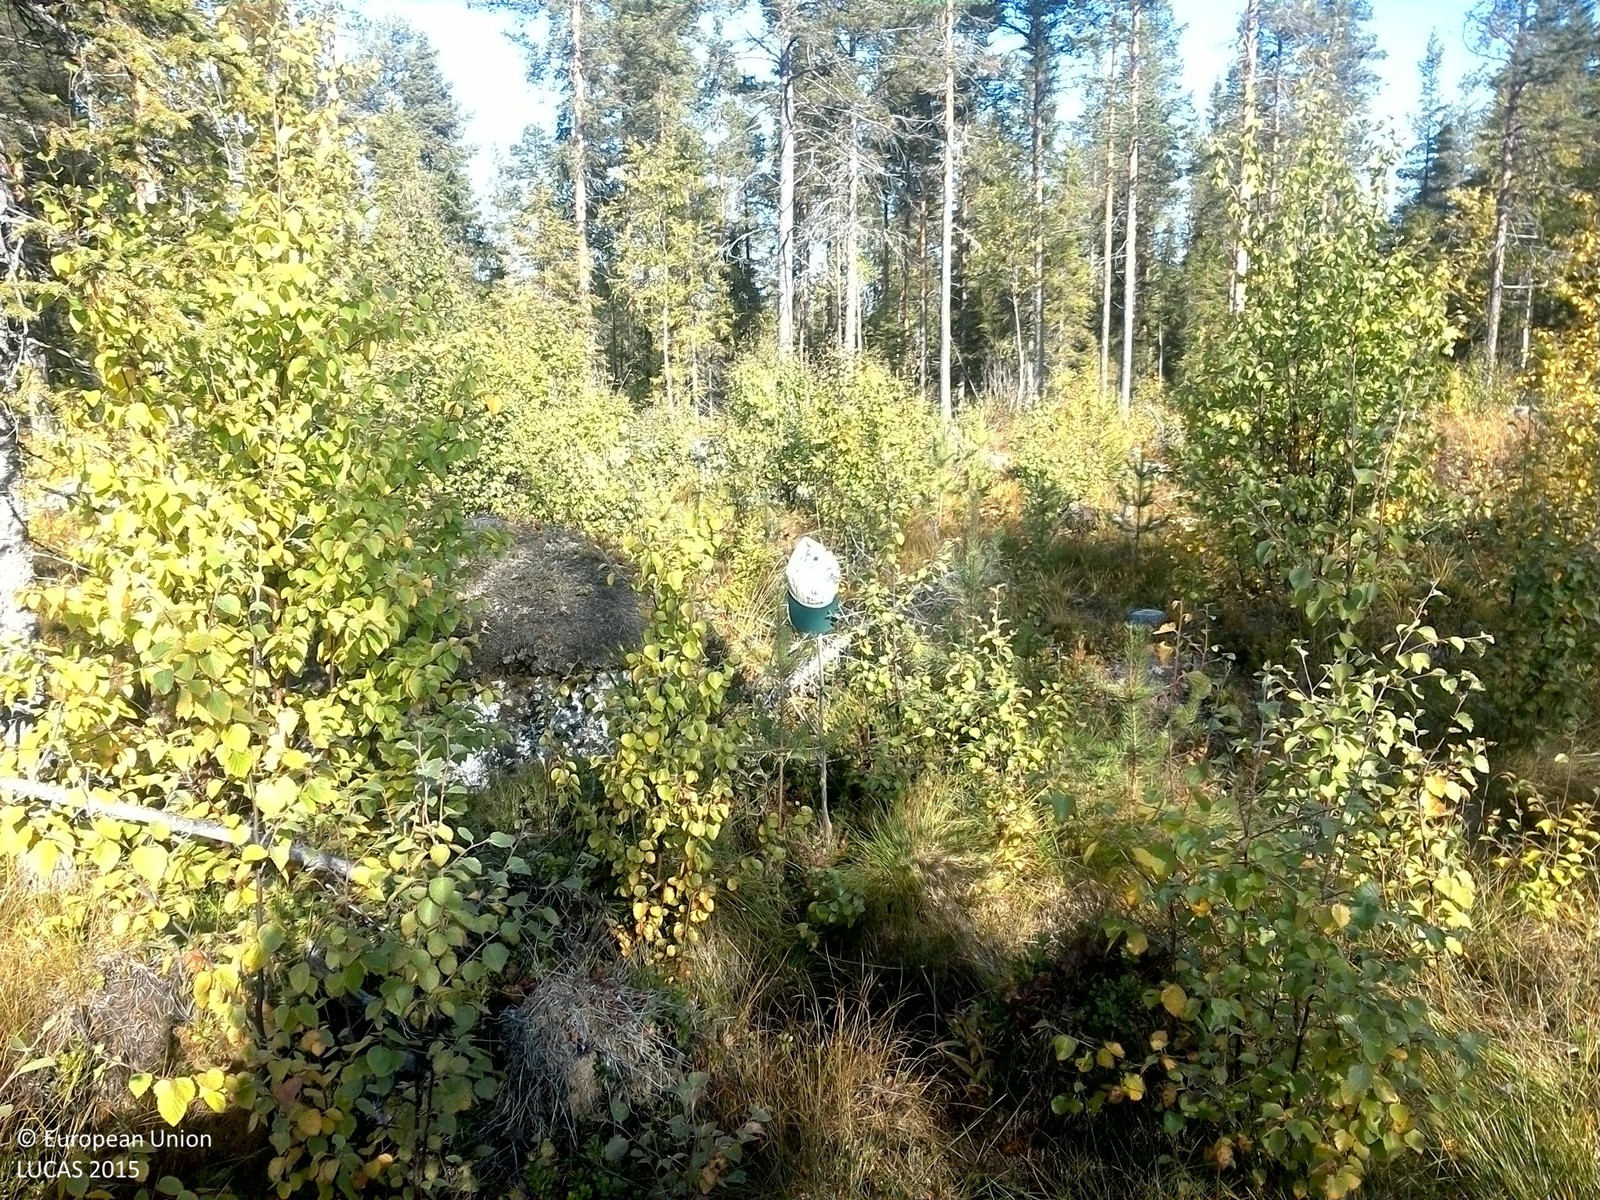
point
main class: Woodland
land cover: Broadleaved woodland
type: boreal forest
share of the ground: 25 - 50 %
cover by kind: broadleaved forest trees 35 %, herbaceous plants 35 %, coniferous forest trees 10 %, shrubs 10 %, lichens and mosses 5 %, unconsolidated bare surface 5 %
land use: Forestry
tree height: < 5 m
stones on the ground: < 10 %
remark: Clear cut
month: September
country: SE
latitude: 64.0636
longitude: 16.5485
